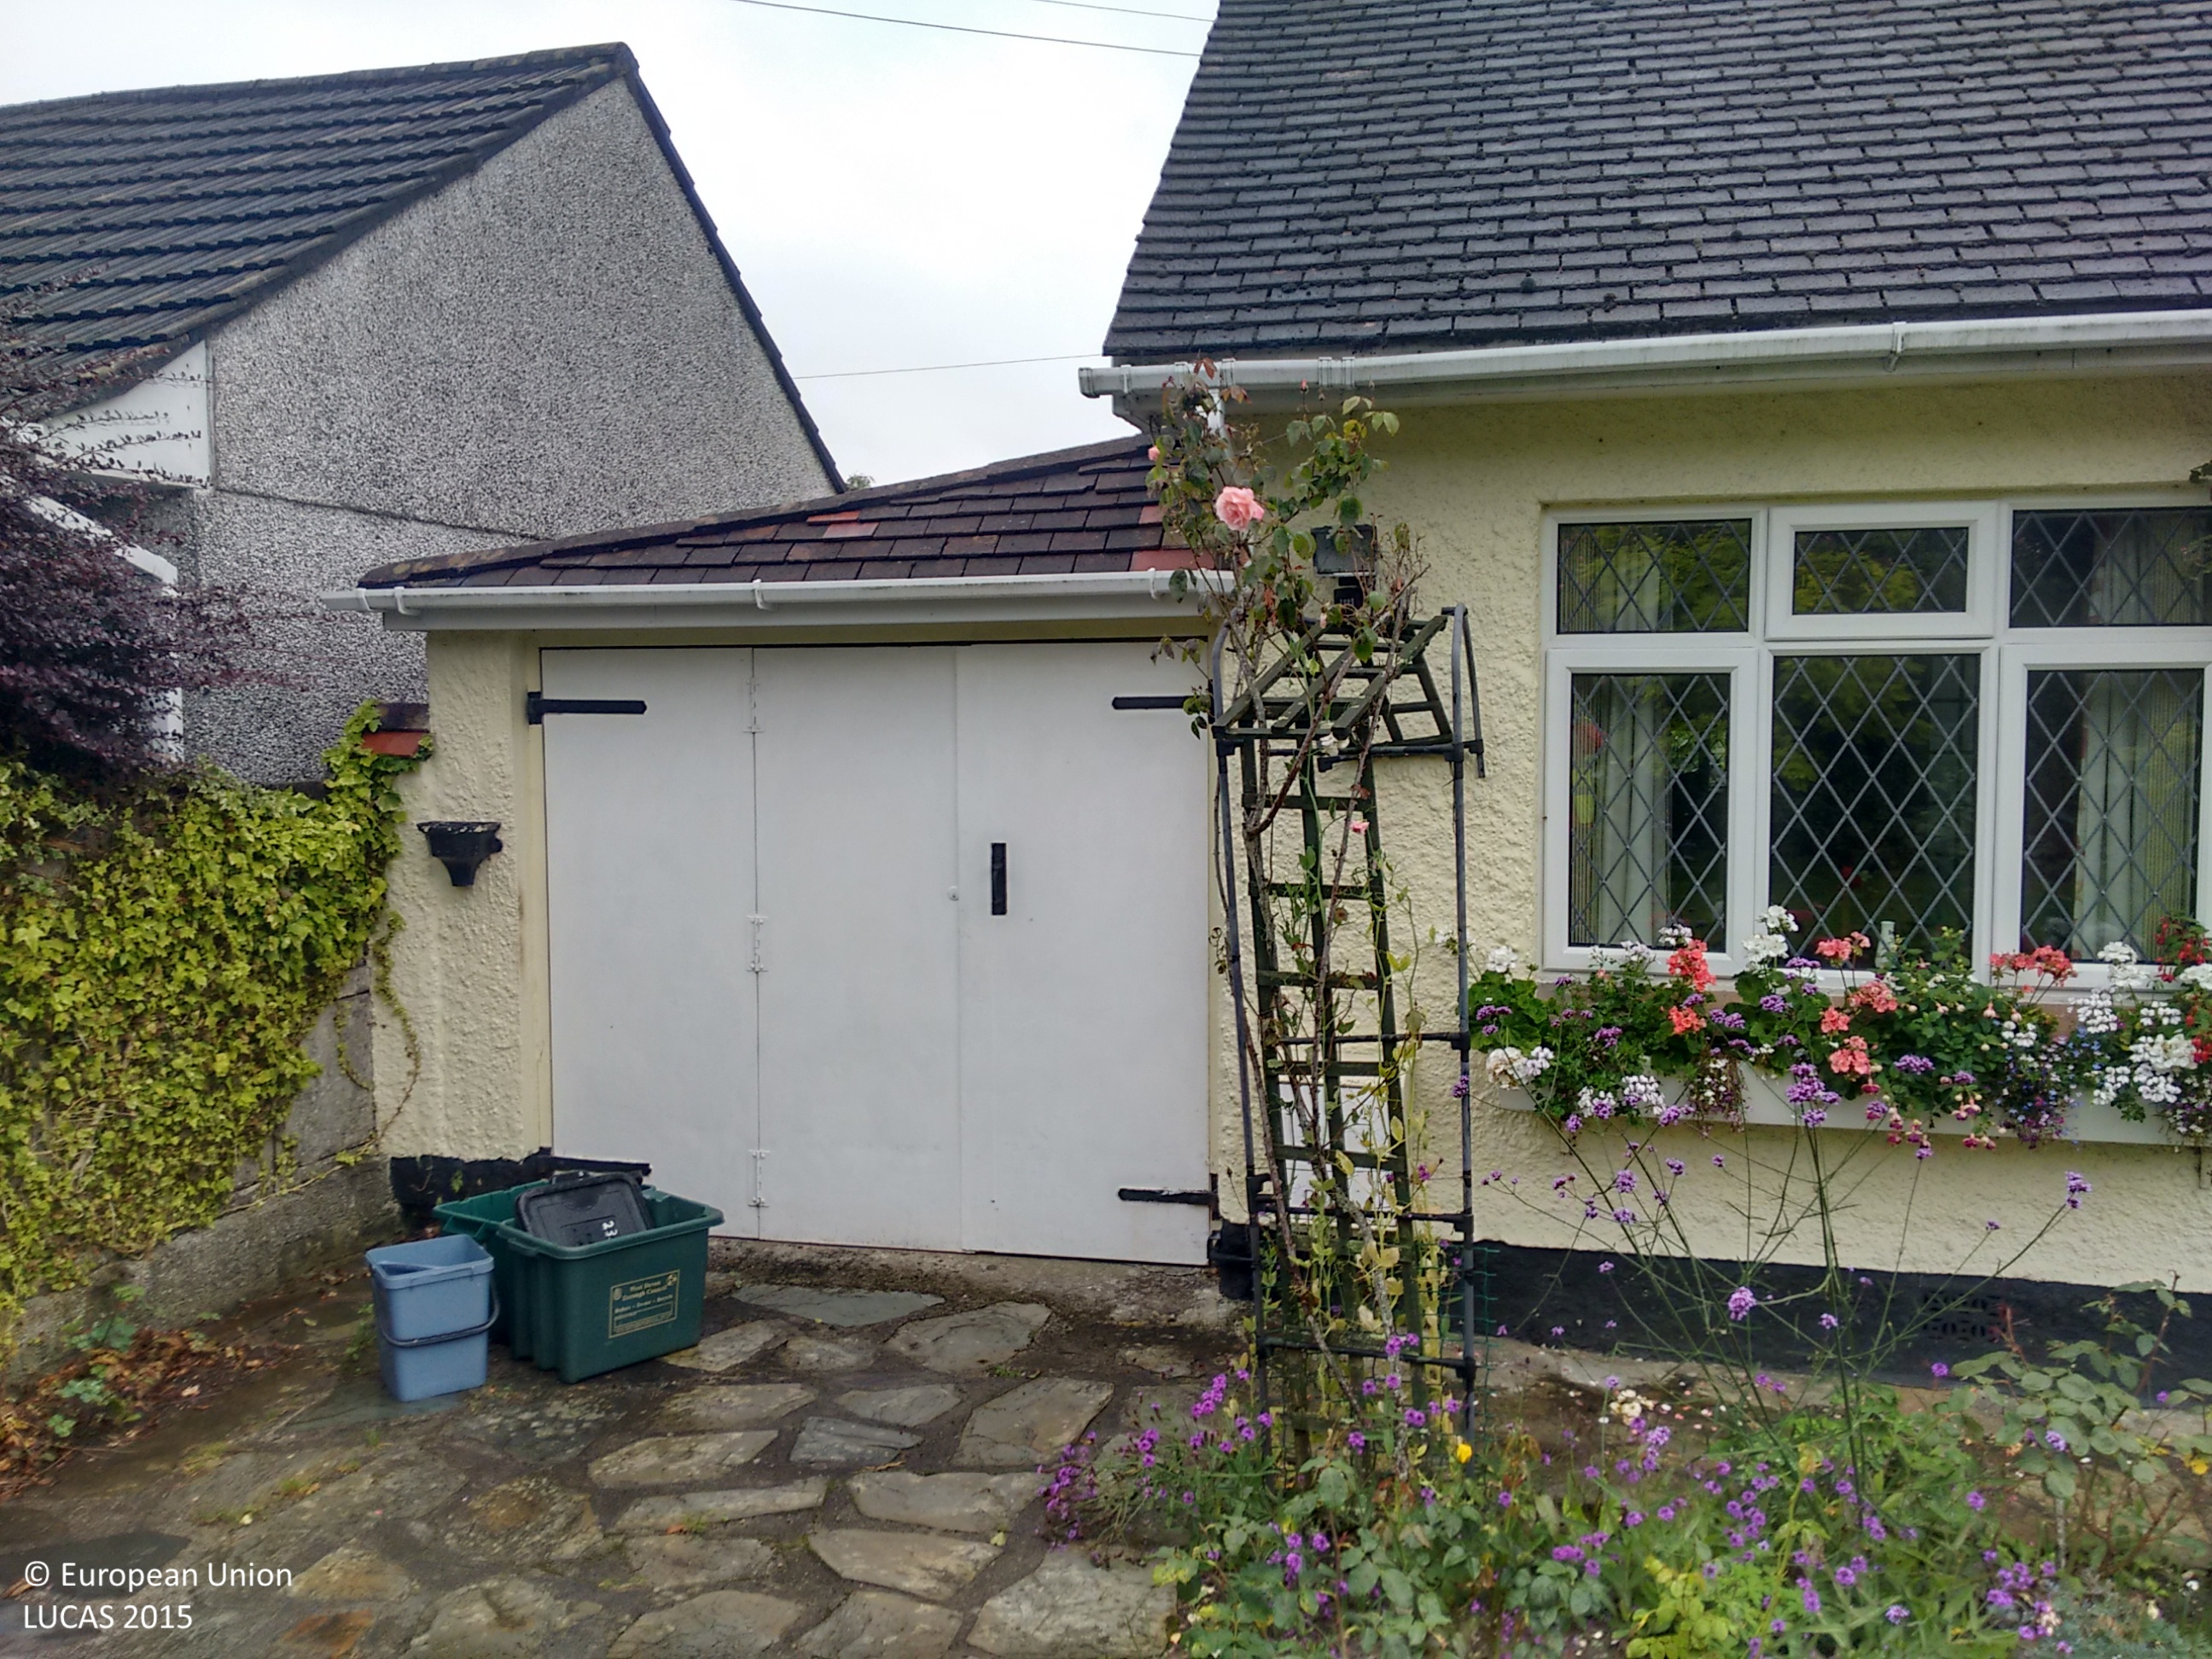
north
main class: Grassland
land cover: Grassland with sparse tree/shrub cover
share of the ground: > 75 %
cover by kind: herbaceous plants 95 %, broadleaved forest trees 5 %
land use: Residential
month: August
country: GB
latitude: 50.5078
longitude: -4.0976
